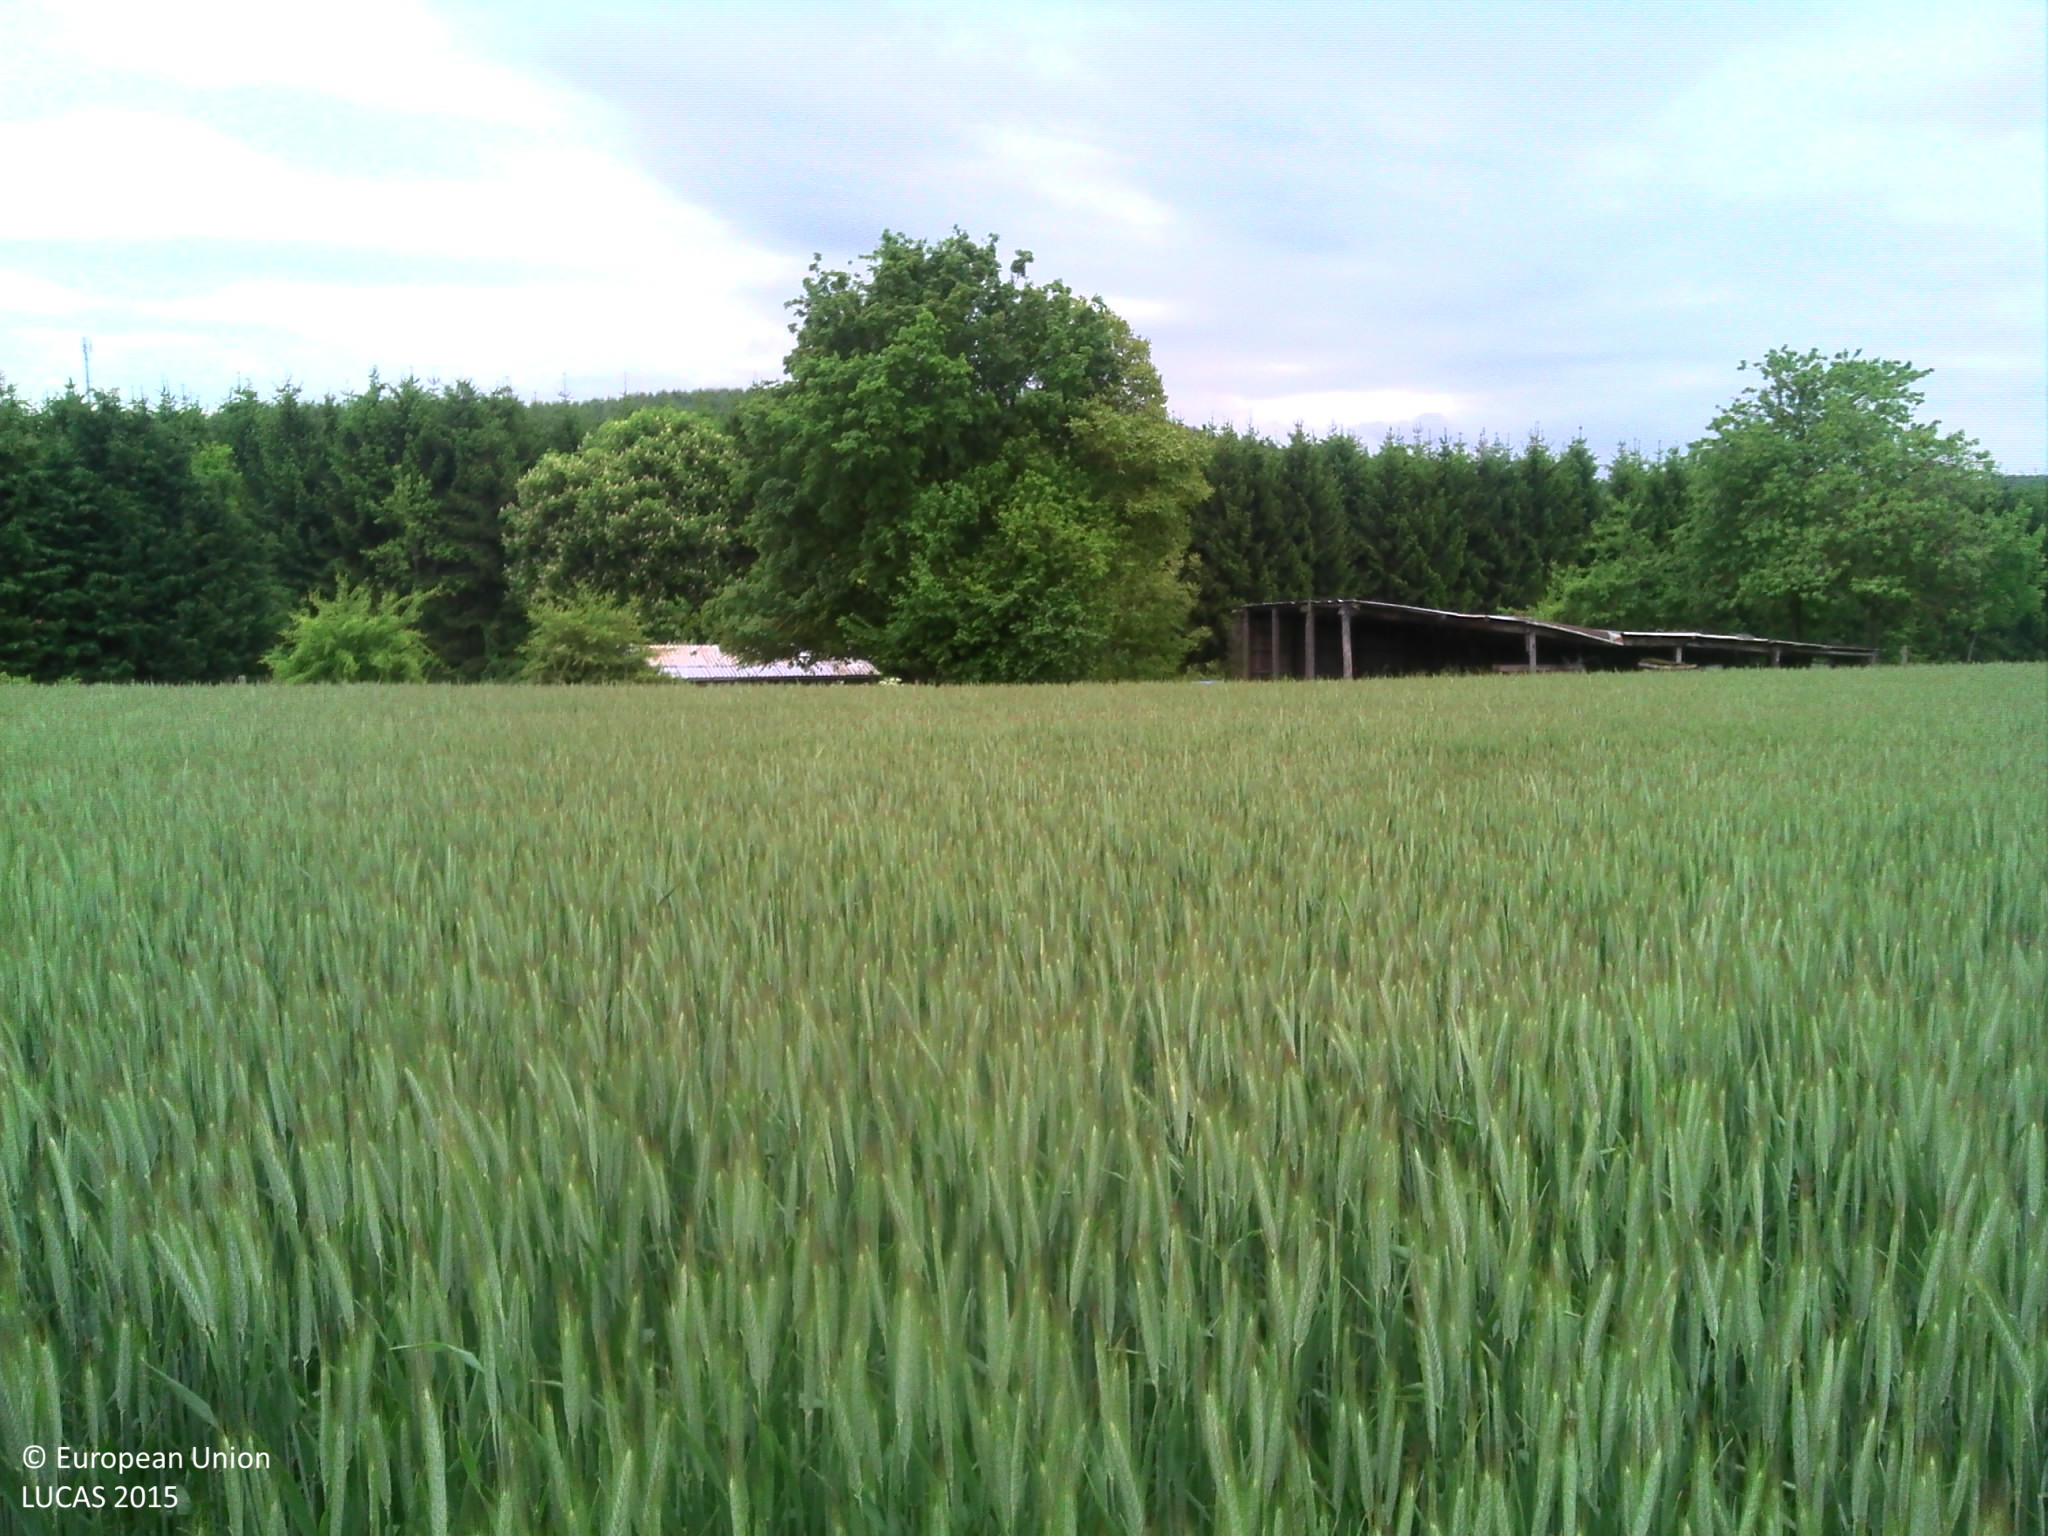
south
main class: Cropland
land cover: Triticale
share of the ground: > 75 %
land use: Agriculture (excluding fallow land and kitchen gardens)
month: May
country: BE
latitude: 50.1575
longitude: 5.2528
